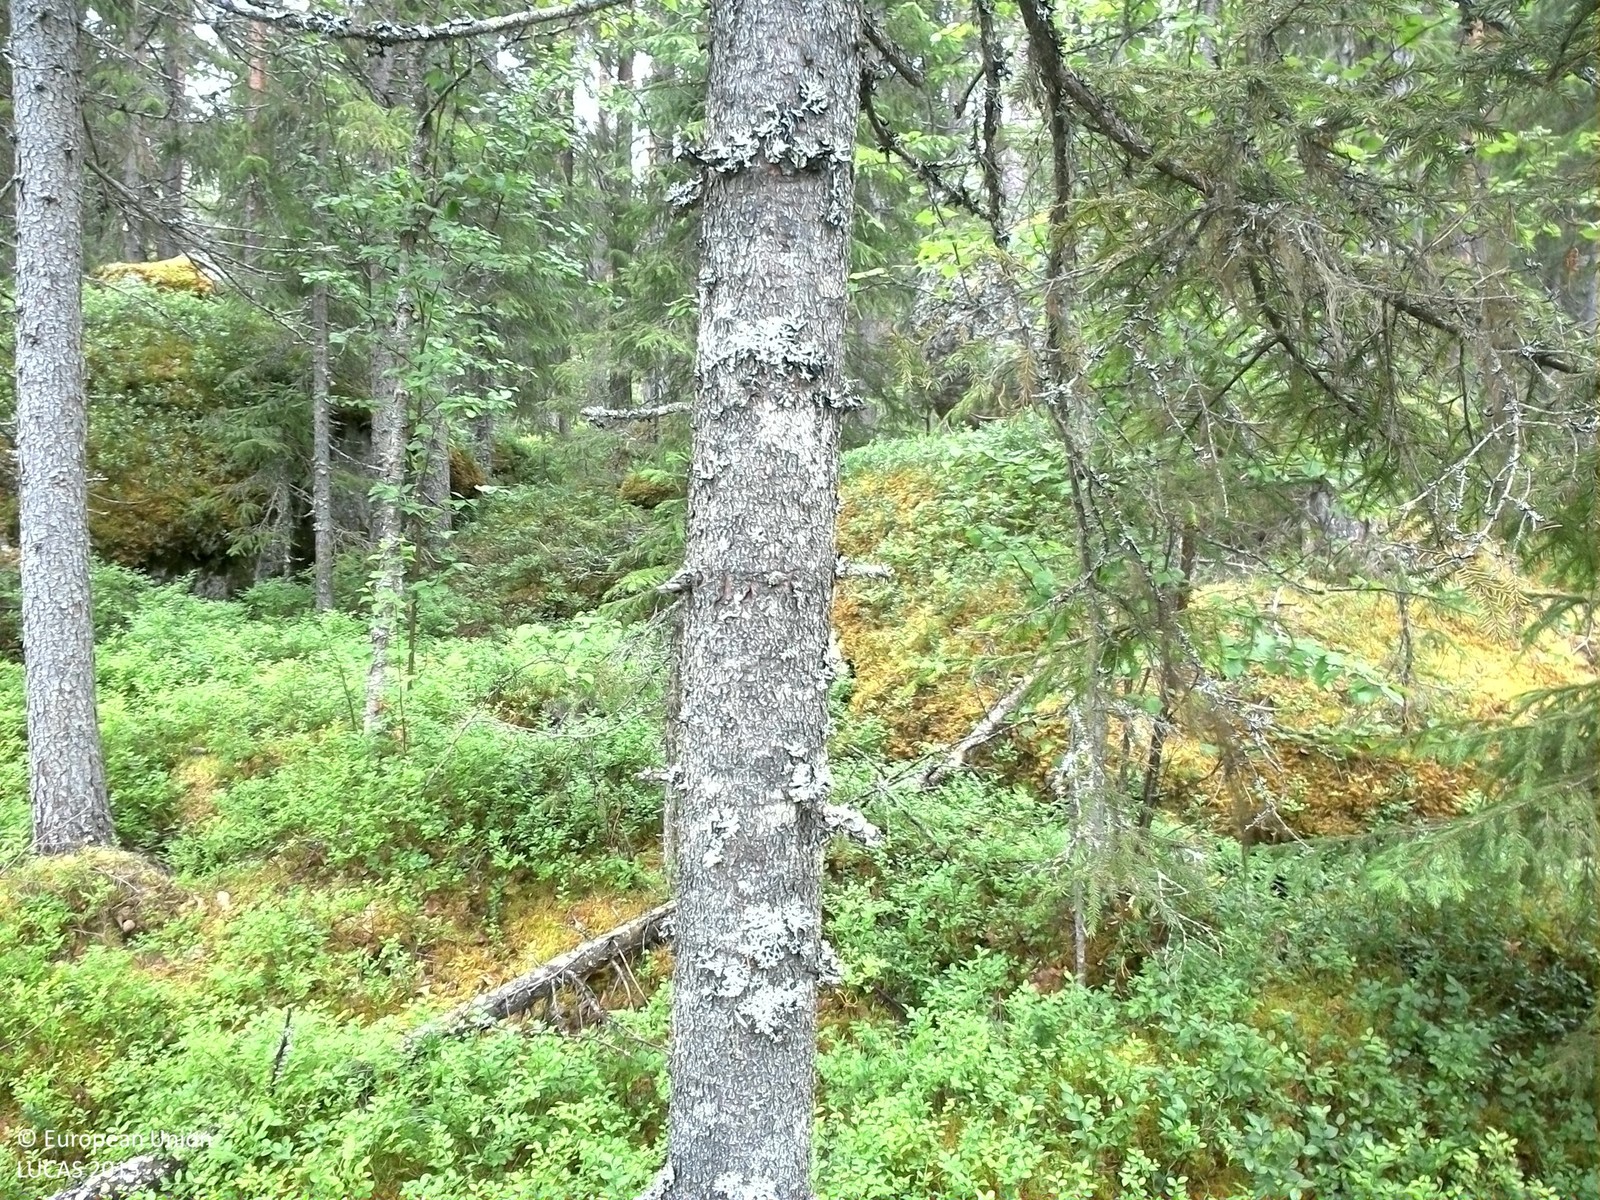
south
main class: Woodland
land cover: Pine dominated coniferous woodland
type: boreal forest
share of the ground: 25 - 50 %
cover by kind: coniferous forest trees 40 %, shrubs 35 %, lichens and mosses 15 %, broadleaved forest trees 5 %, consolidated bare surface 5 %
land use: Forestry
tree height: > 5 m
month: August
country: SE
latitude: 63.5676
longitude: 16.2760
